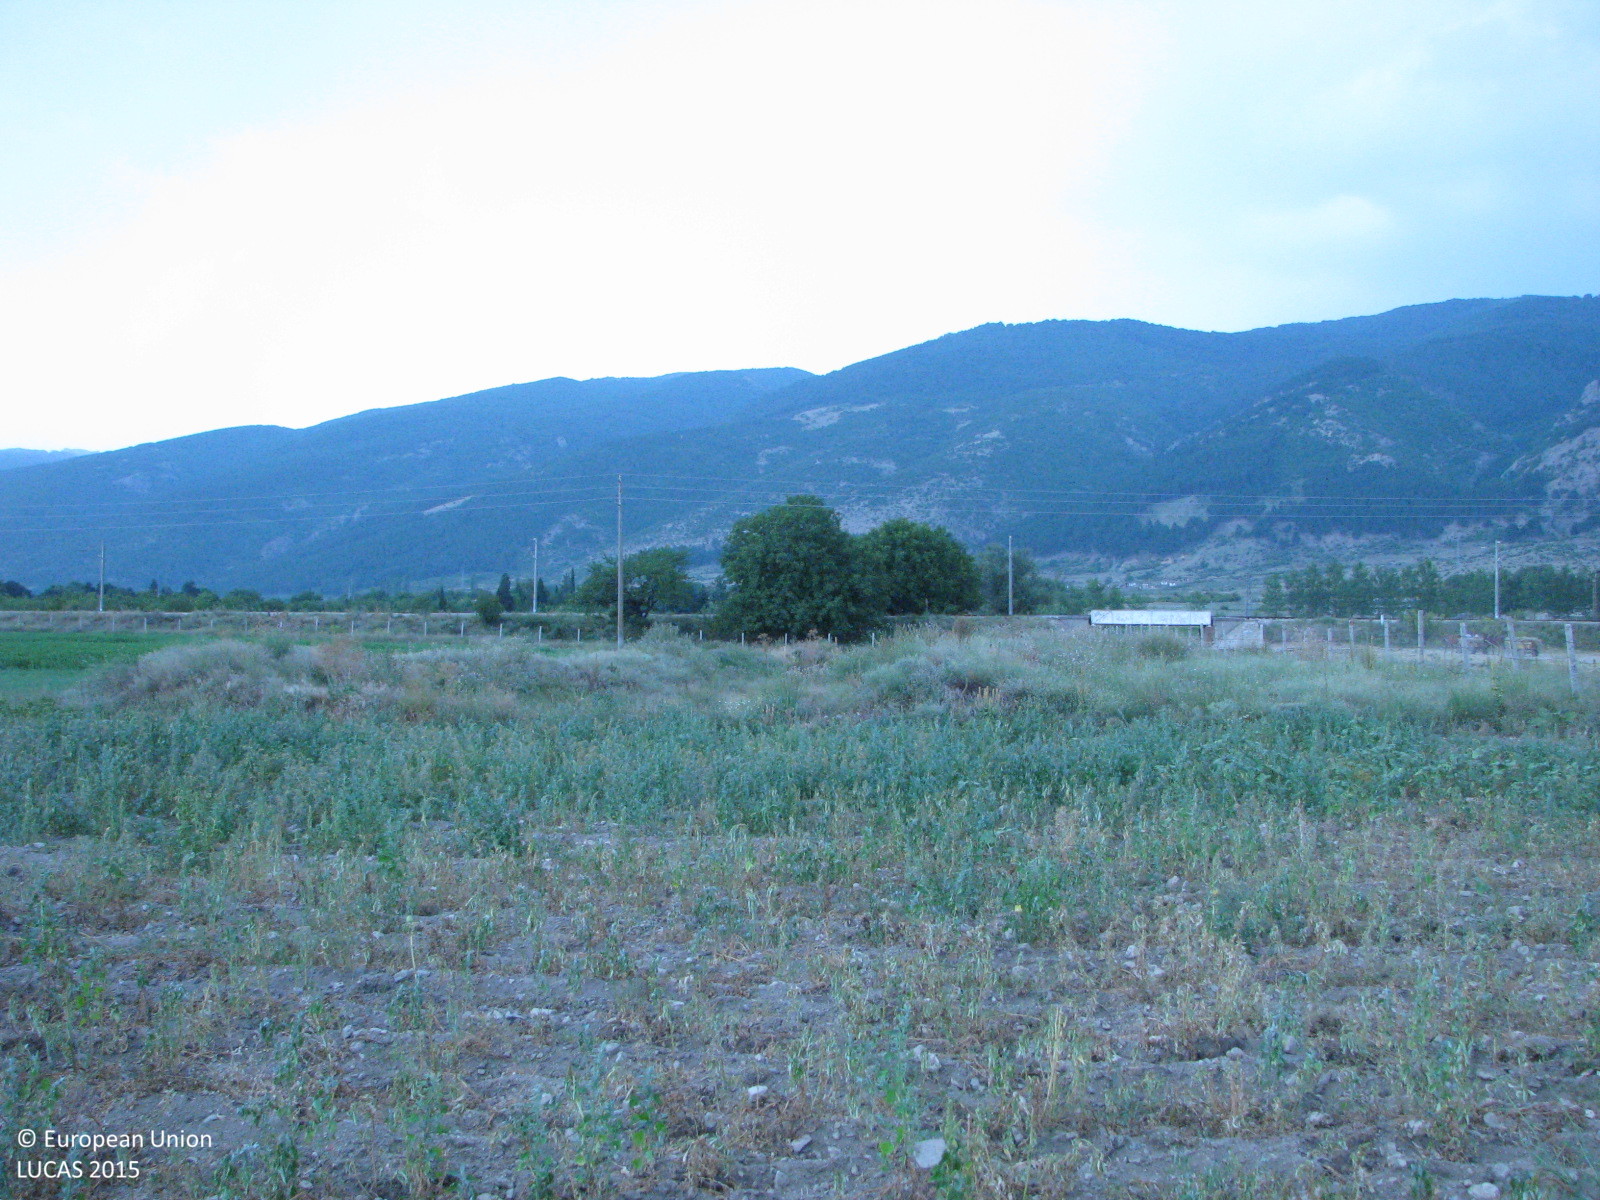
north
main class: Cropland
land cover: Potatoes
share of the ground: 25 - 50 %
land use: Agriculture (excluding fallow land and kitchen gardens)
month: July
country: BG
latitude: 42.6795
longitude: 25.9838
